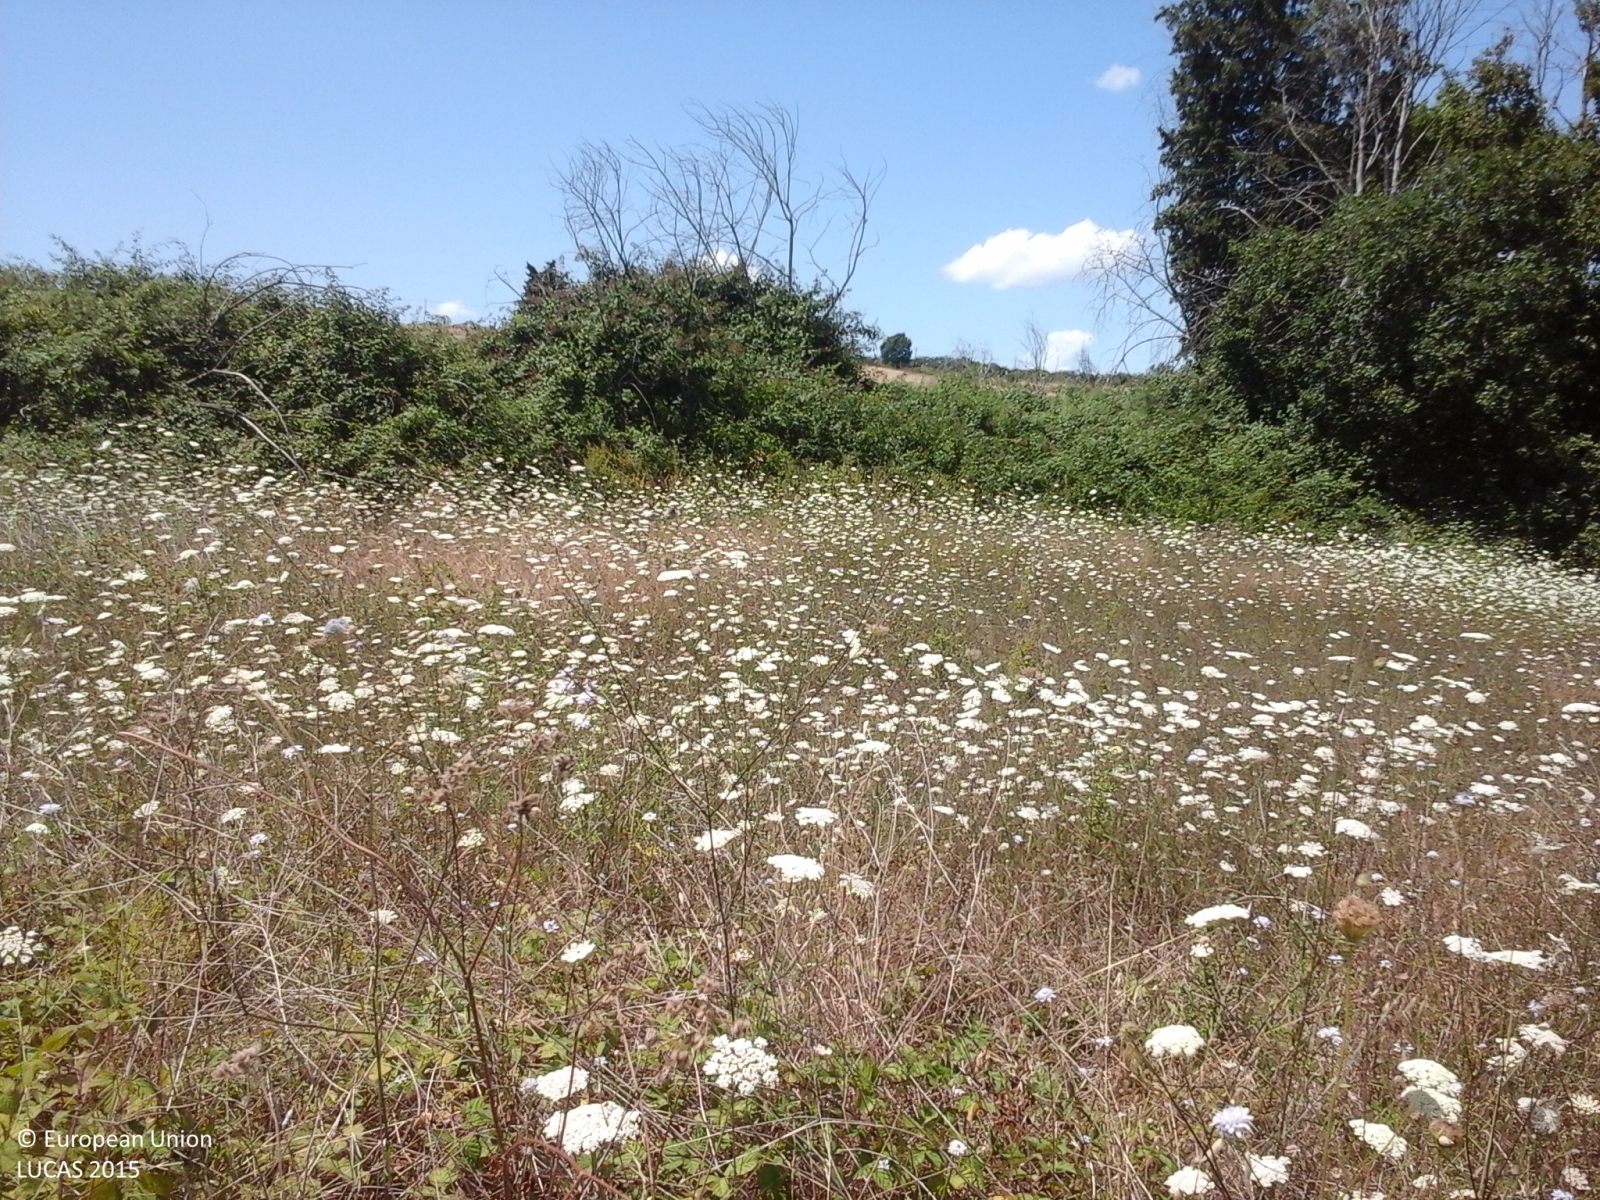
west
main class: Grassland
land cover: Grassland without tree/shrub cover
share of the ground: > 75 %
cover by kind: herbaceous plants 100 %
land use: Agriculture (excluding fallow land and kitchen gardens)
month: August
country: IT
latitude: 43.1838
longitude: 11.5579
